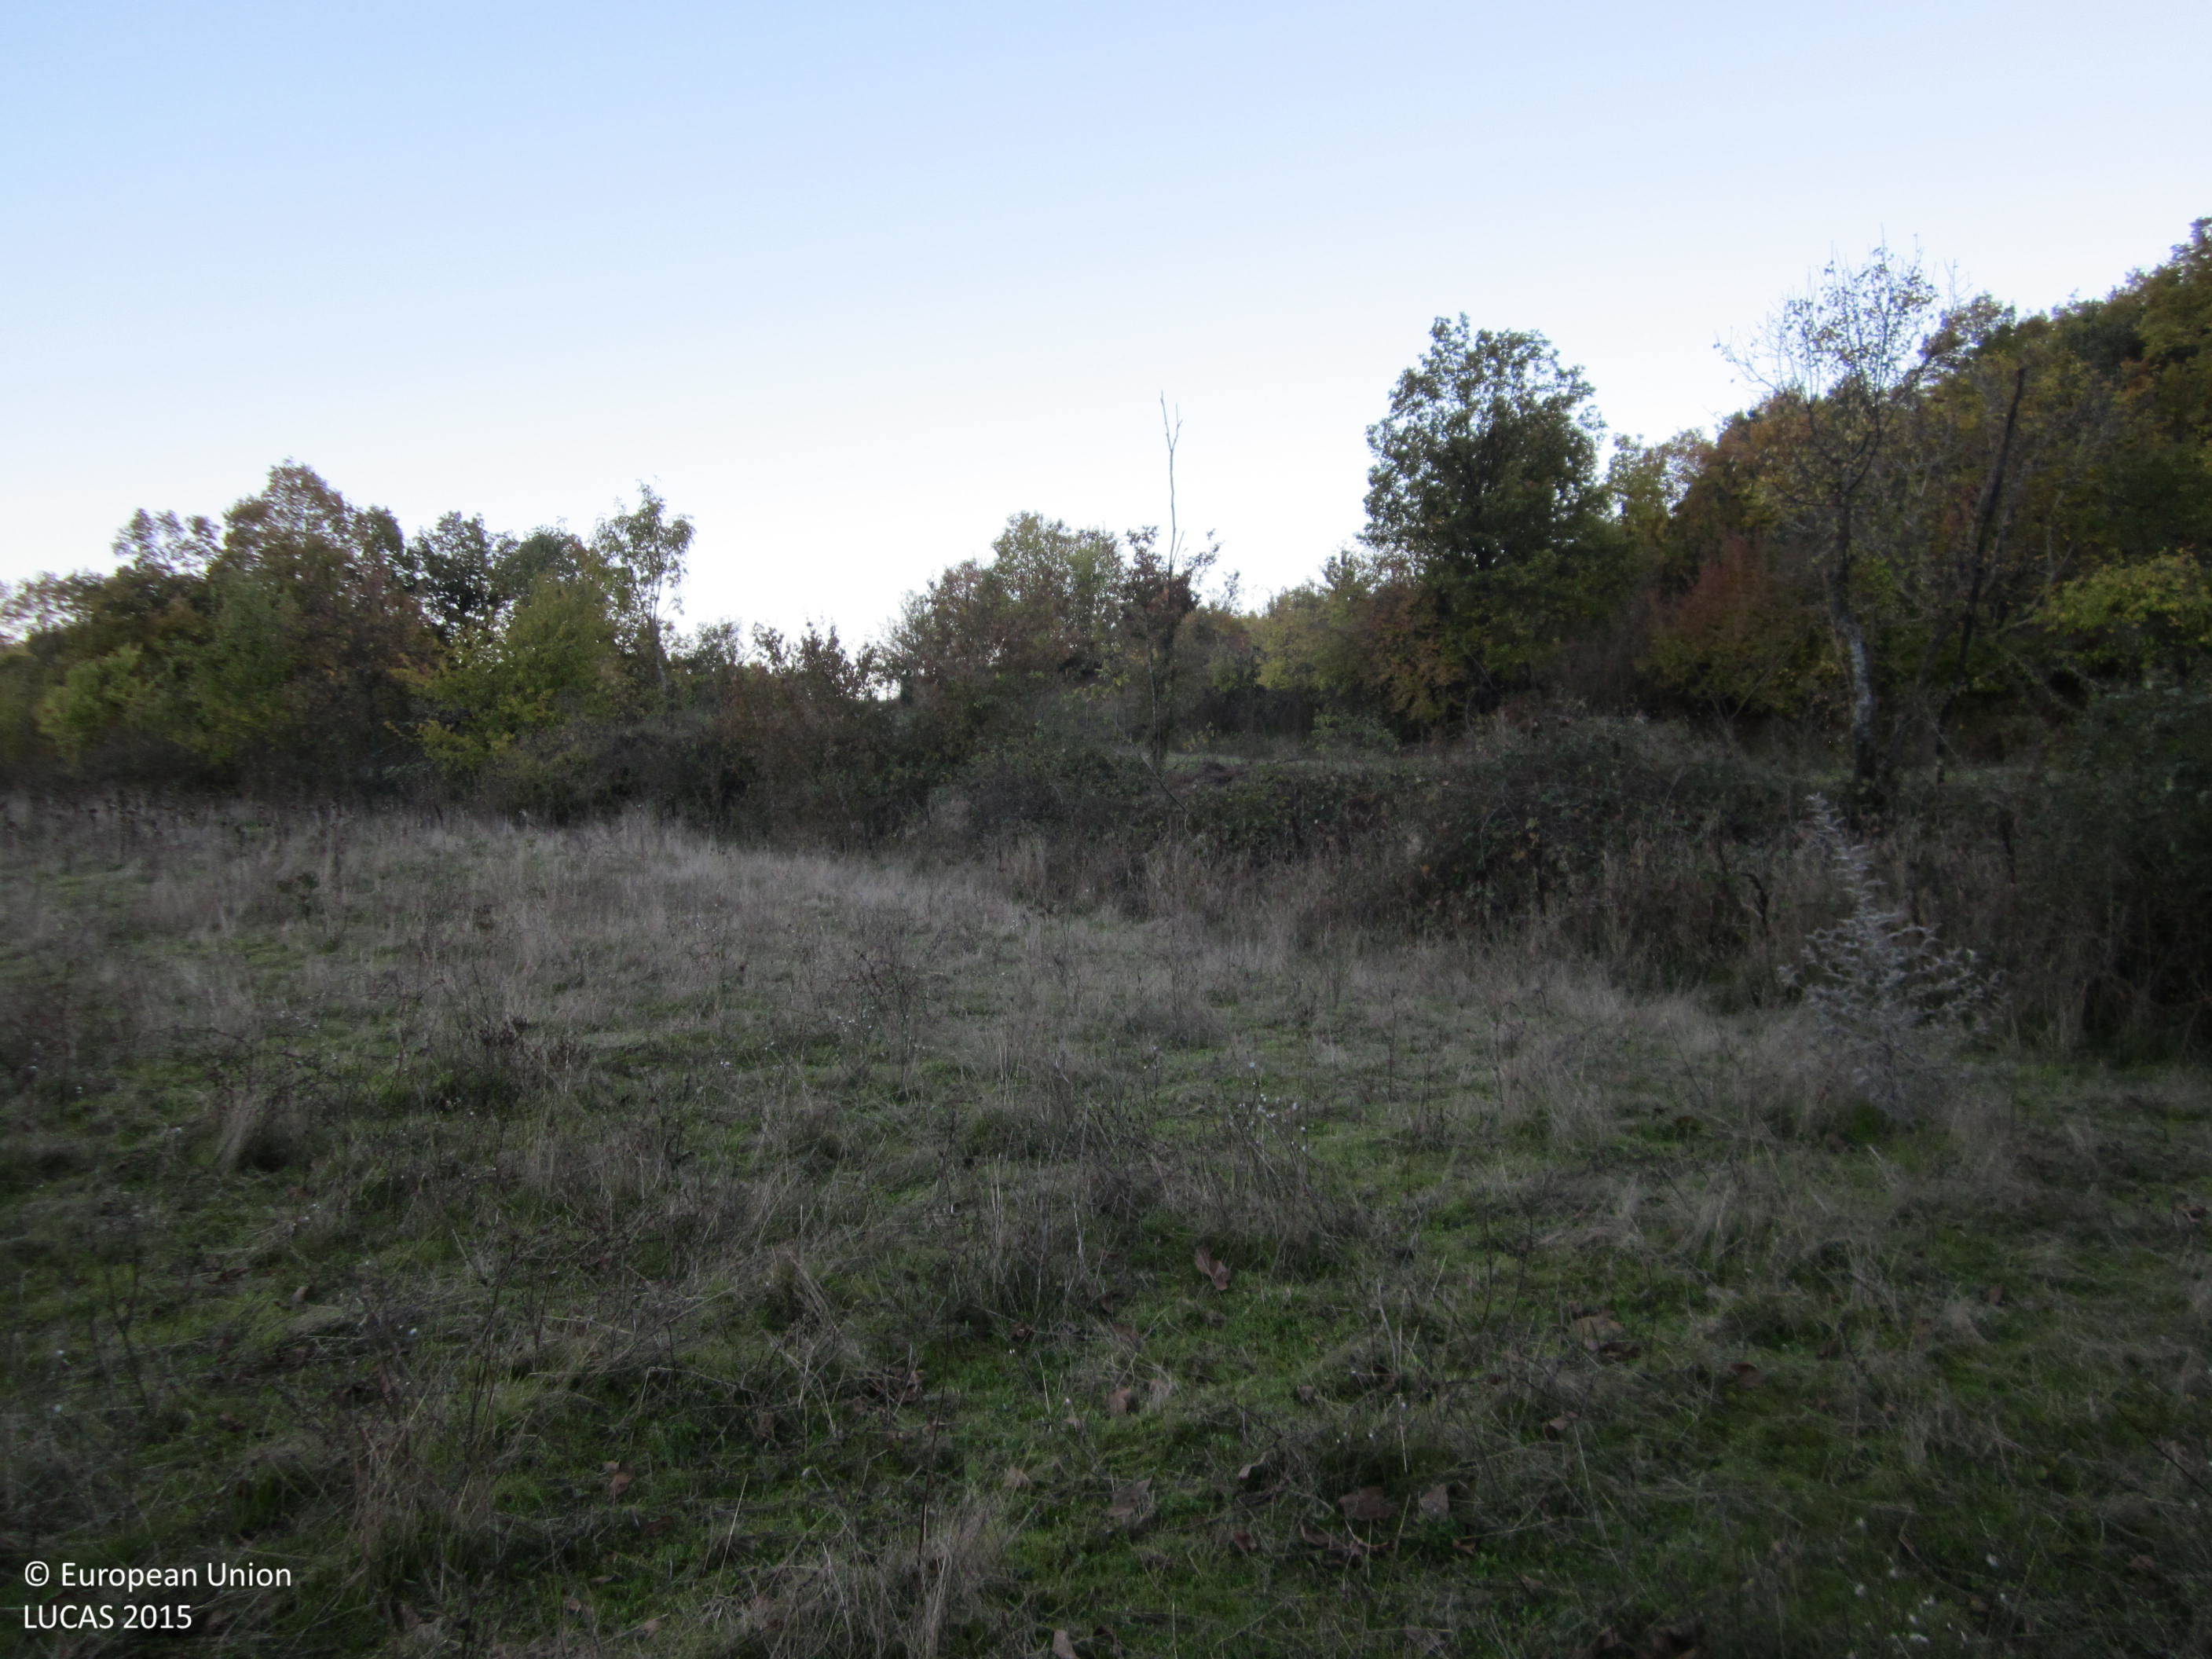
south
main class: Grassland
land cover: Grassland with sparse tree/shrub cover
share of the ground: > 75 %
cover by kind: herbaceous plants 90 %, broadleaved forest trees 5 %, shrubs 5 %
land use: Agriculture (excluding fallow land and kitchen gardens)
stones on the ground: < 10 %
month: November
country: BG
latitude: 41.4108
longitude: 25.6471
